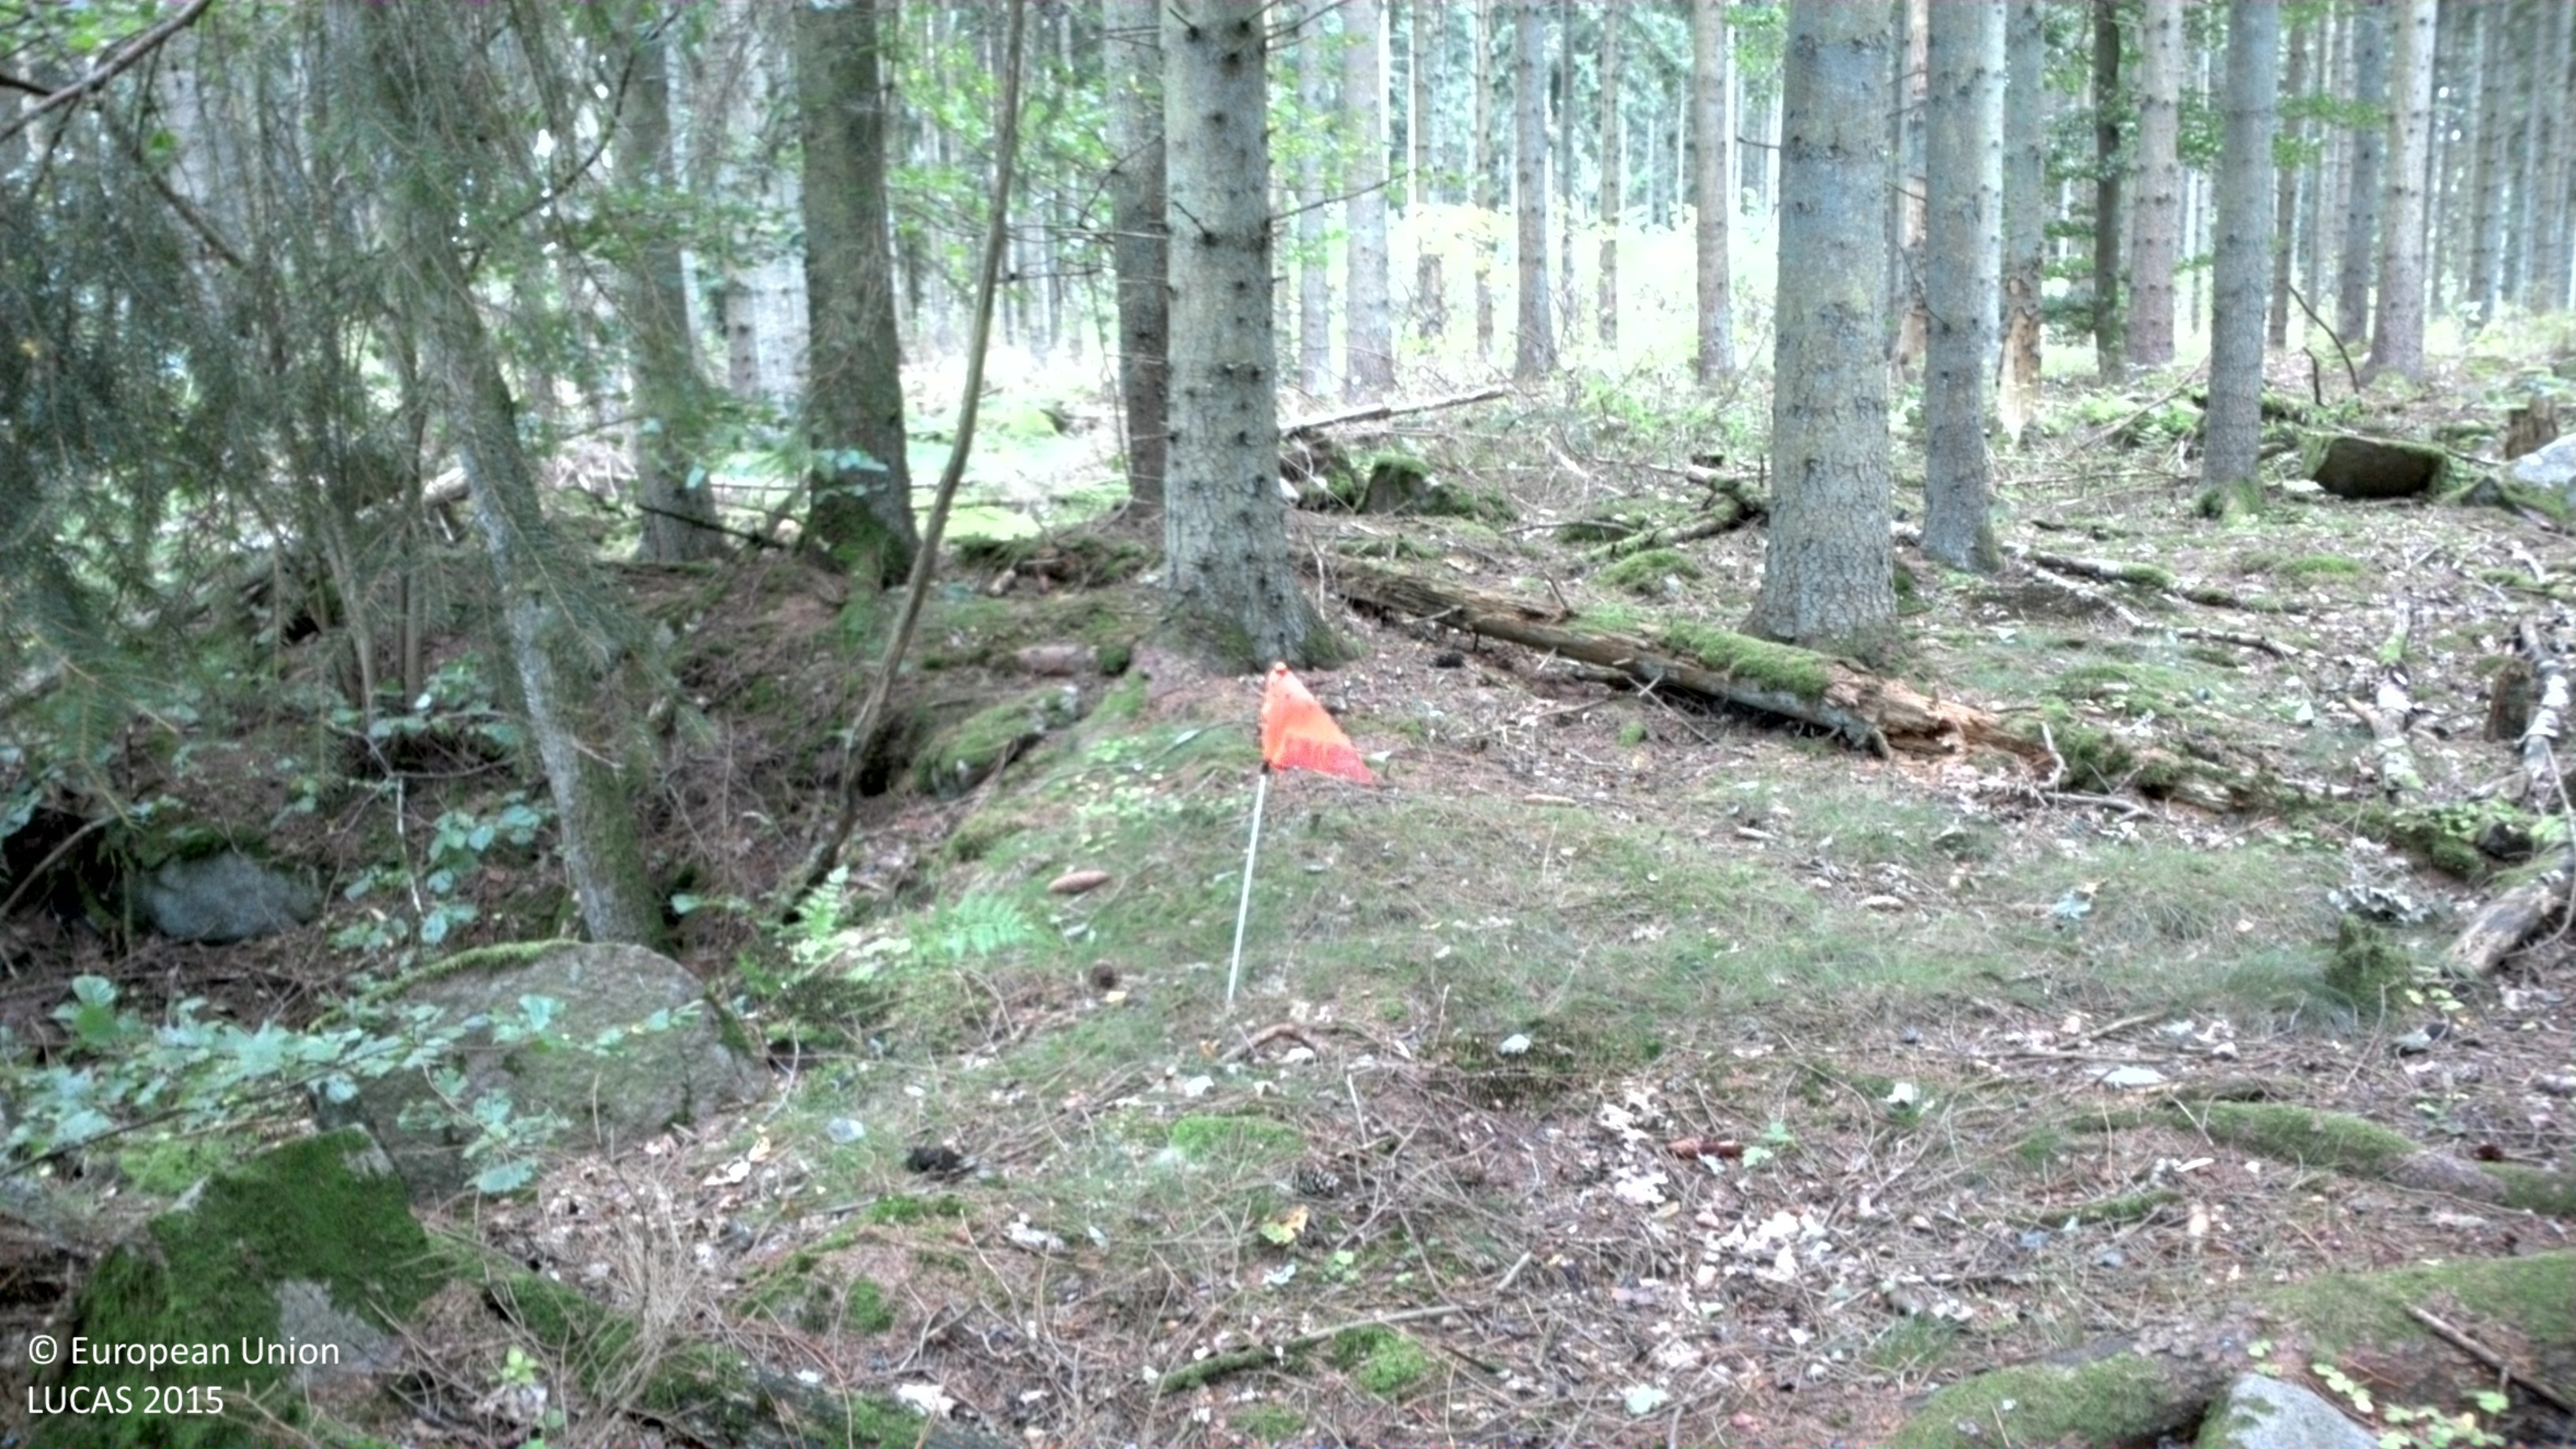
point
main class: Woodland
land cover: Spruce dominated coniferous woodland
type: boreal forest
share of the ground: > 75 %
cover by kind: coniferous forest trees 75 %, lichens and mosses 15 %, broadleaved forest trees 5 %, shrubs 5 %
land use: Forestry
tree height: > 5 m
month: September
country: SE
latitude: 56.1223
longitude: 14.0996
